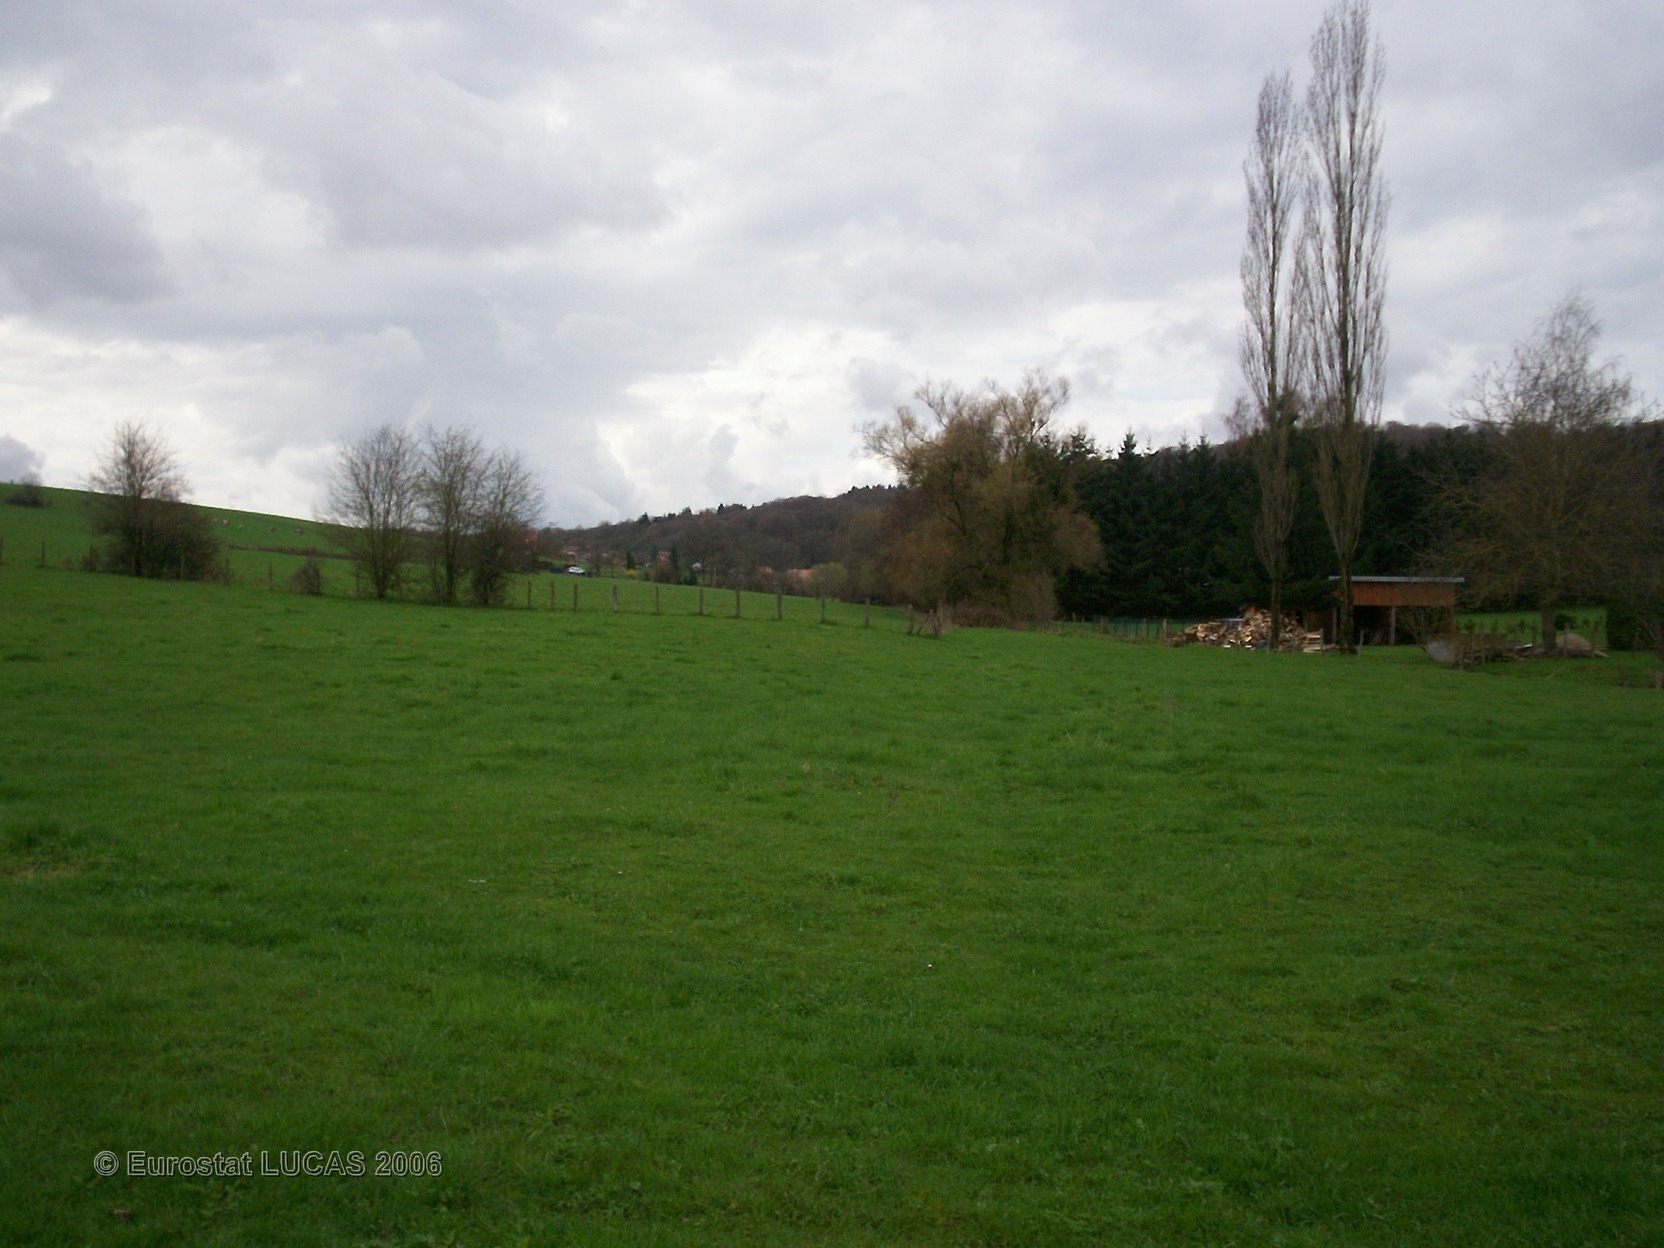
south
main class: Grassland
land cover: Grassland with sparse tree/shrub cover
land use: Agriculture (excluding fallow land and kitchen gardens)
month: April
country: FR
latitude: 47.5419
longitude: 6.6403
